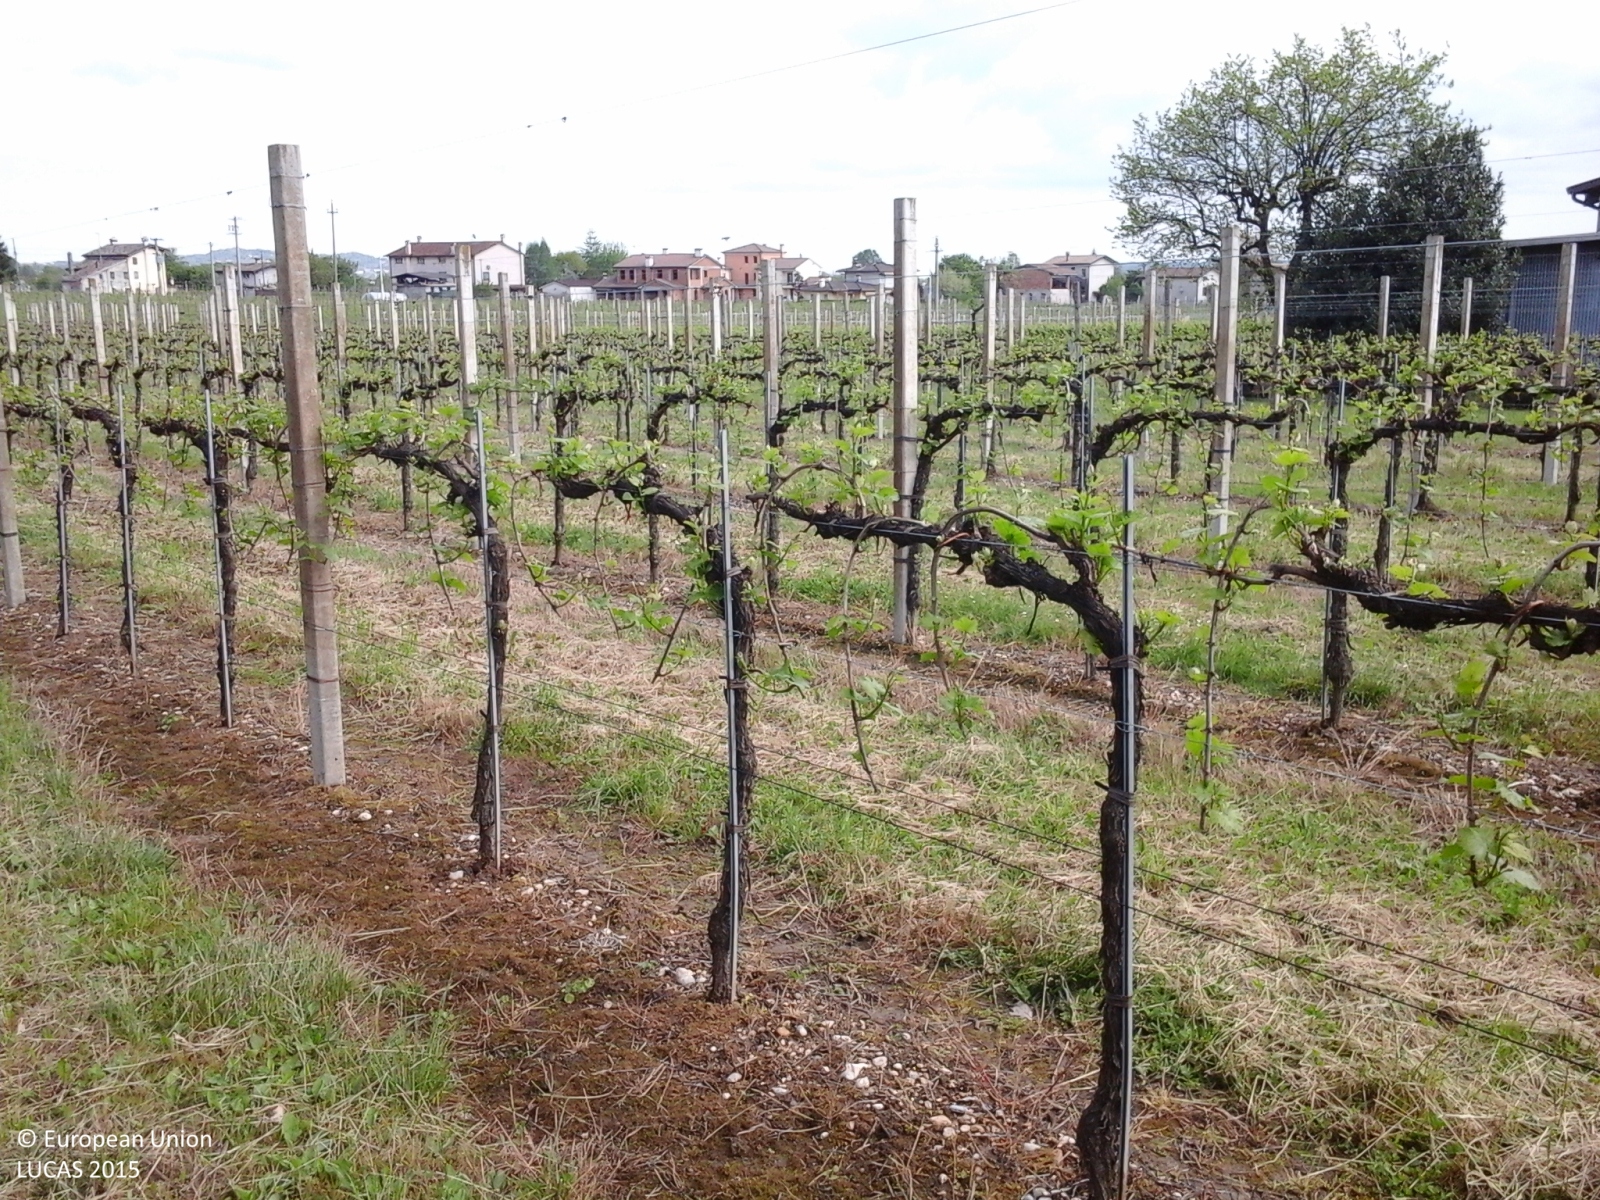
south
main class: Cropland
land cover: Vineyards
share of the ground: < 10 %
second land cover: Grassland without tree/shrub cover
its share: > 75 %
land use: Agriculture (excluding fallow land and kitchen gardens)
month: April
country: IT
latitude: 45.8976
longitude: 12.1237
